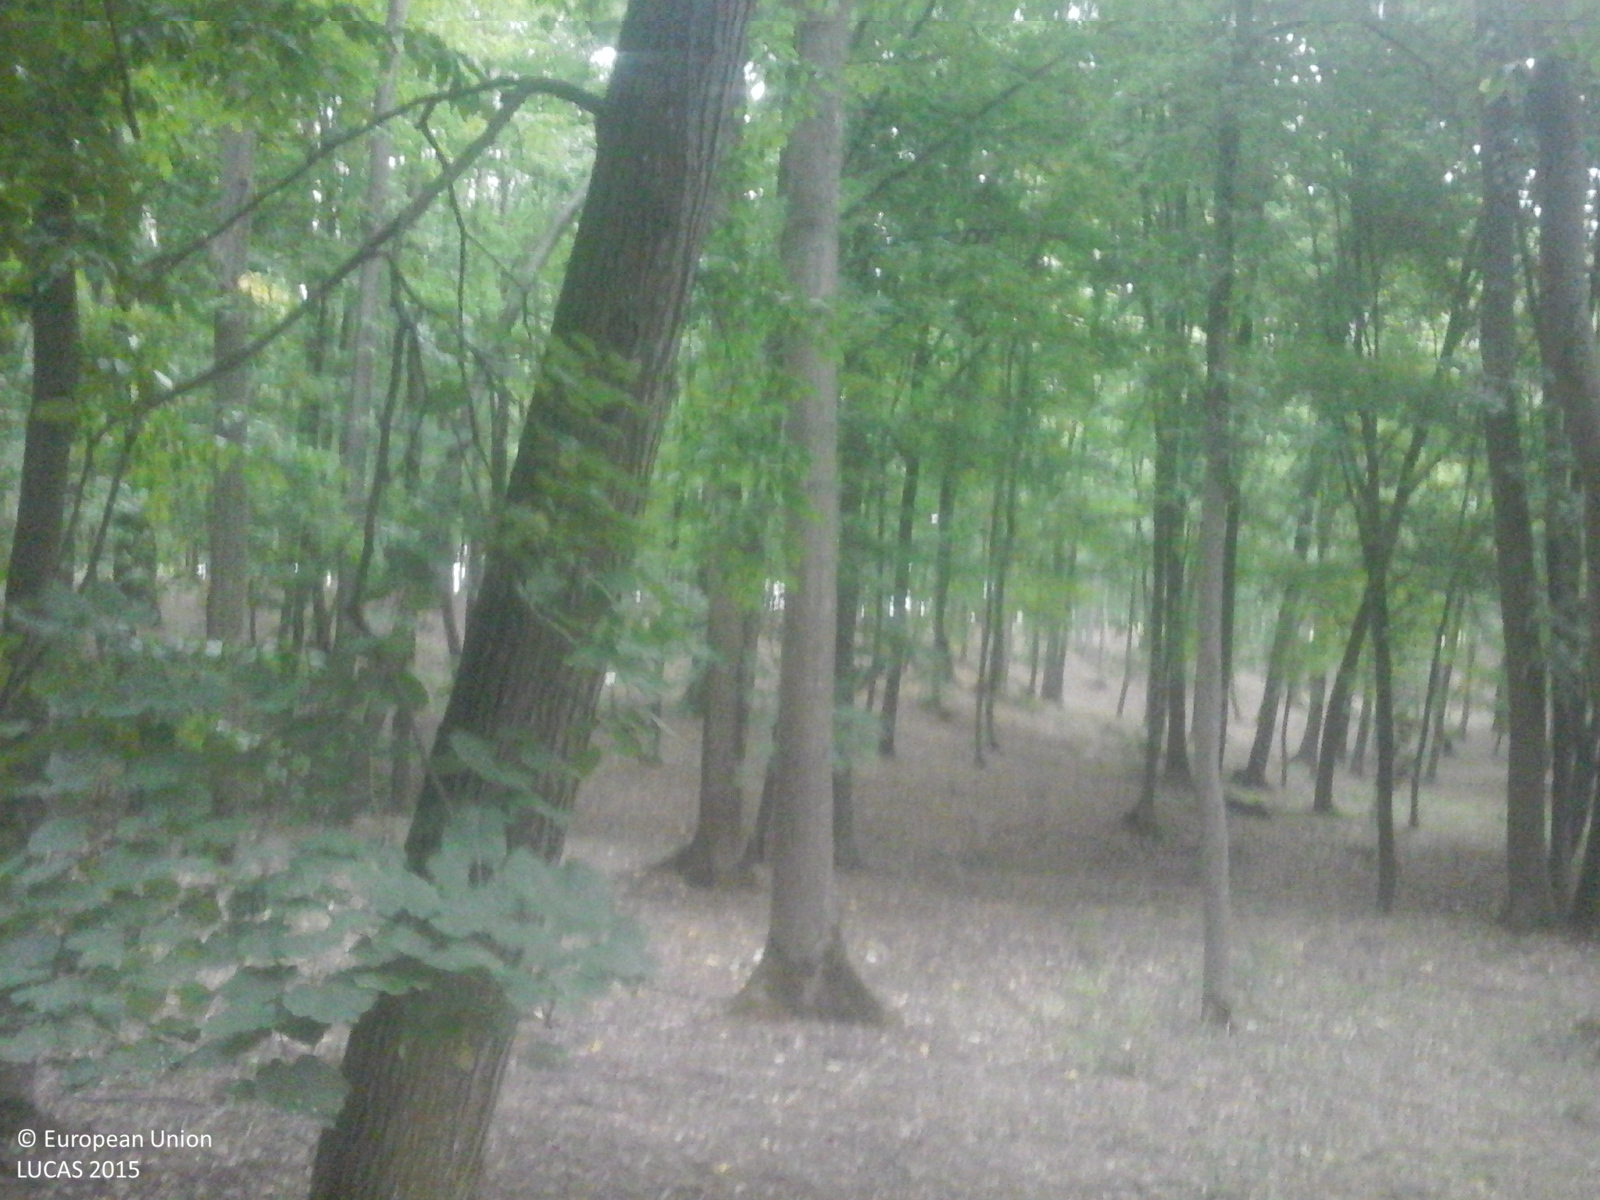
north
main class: Woodland
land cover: Broadleaved woodland
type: beech forest
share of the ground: > 75 %
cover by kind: broadleaved forest trees 95 %, herbaceous plants 5 %
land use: Forestry
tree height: > 5 m
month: June
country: RO
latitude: 47.6382
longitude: 26.8025
